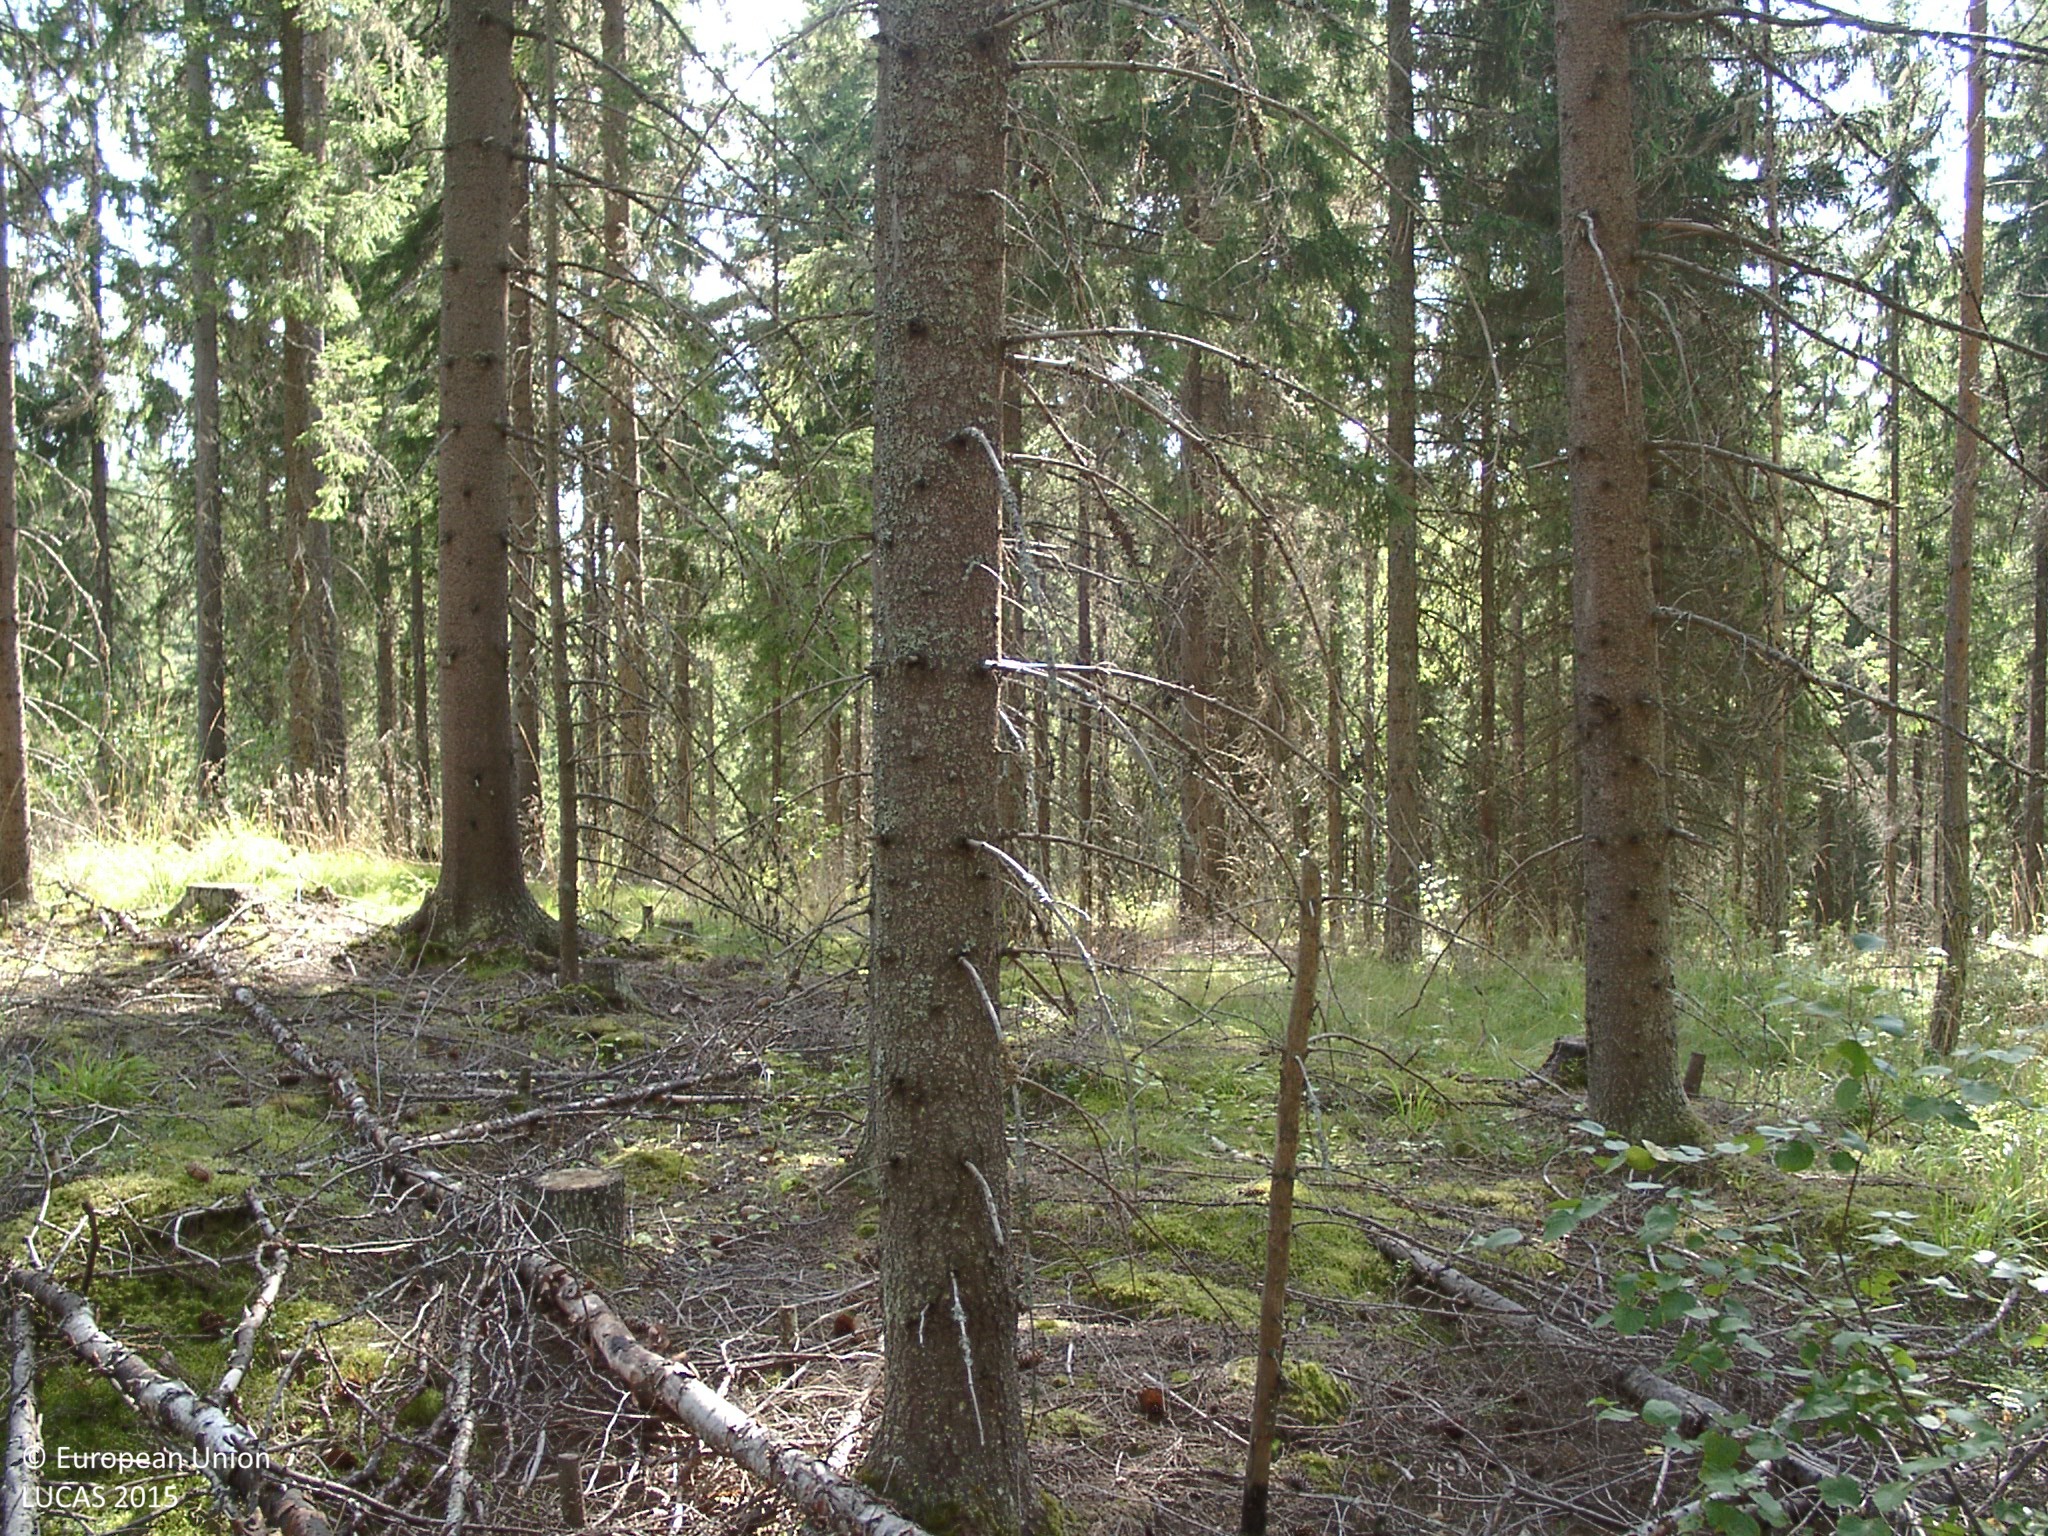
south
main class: Woodland
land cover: Spruce dominated coniferous woodland
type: boreal forest
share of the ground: 50 - 75 %
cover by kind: coniferous forest trees 65 %, lichens and mosses 10 %, shrubs 5 %, herbaceous plants 5 %, unconsolidated bare surface 5 %
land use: Forestry
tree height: > 5 m
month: August
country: FI
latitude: 61.7707
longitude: 25.0999
